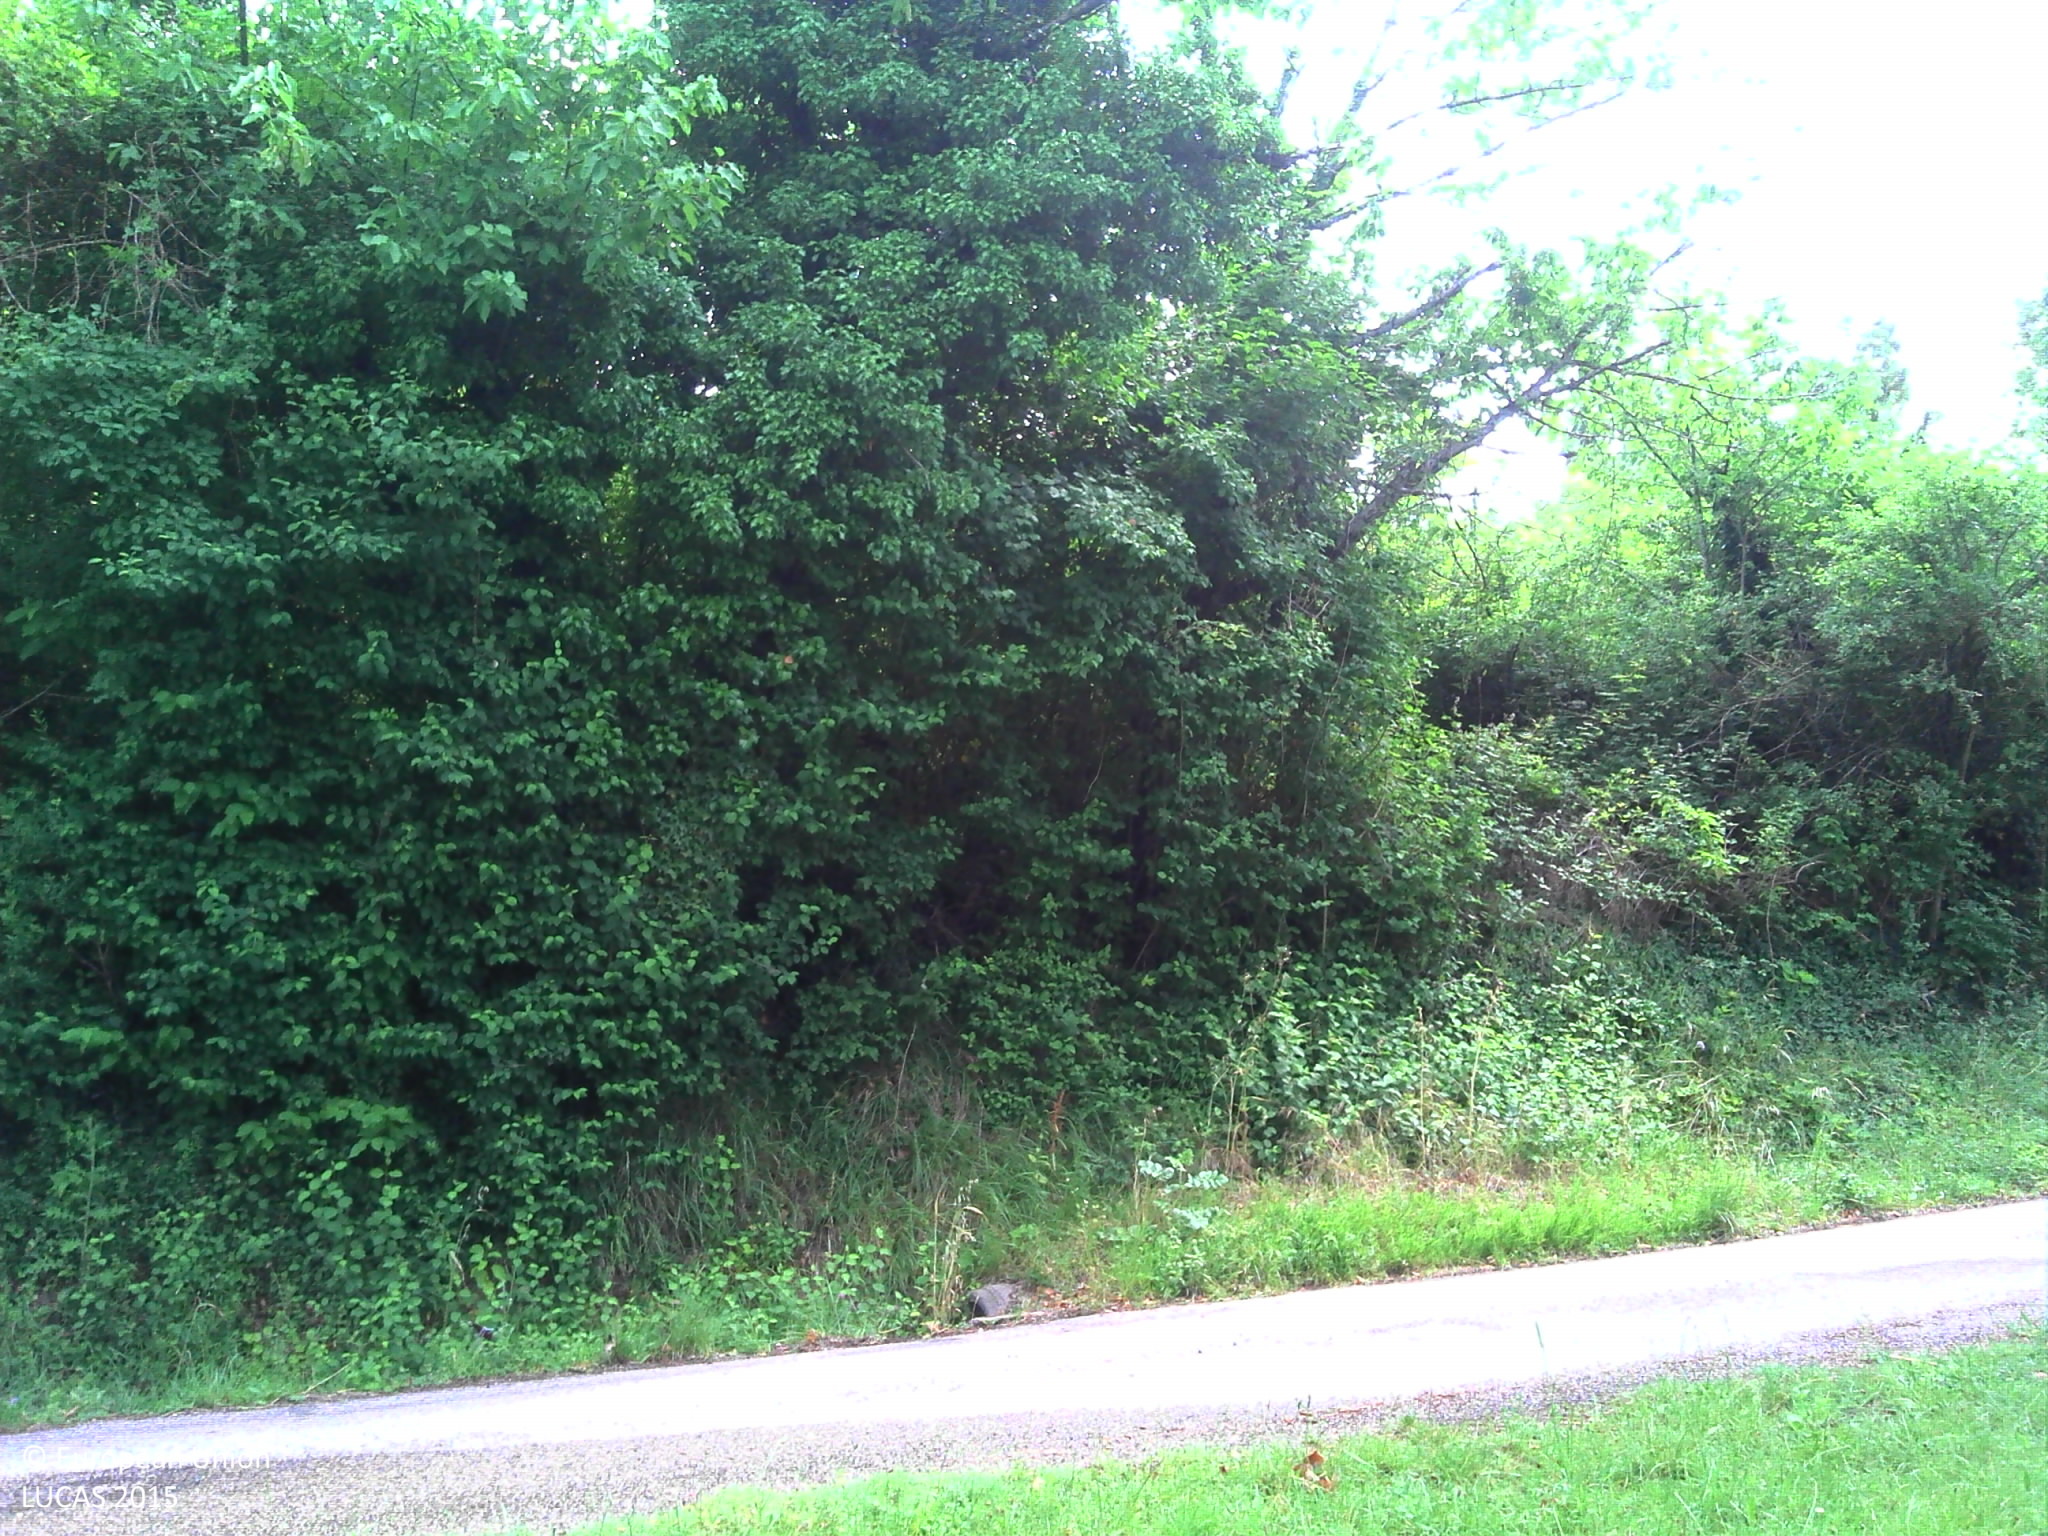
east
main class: Grassland
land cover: Grassland with sparse tree/shrub cover
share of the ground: > 75 %
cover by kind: herbaceous plants 95 %, broadleaved forest trees 5 %
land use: Residential
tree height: > 5 m
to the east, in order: Grassland with sparse tree/shrub cover; Artificial constructions in urban areas; Broadleaved woodland; Artificial constructions in urban areas; Broadleaved woodland
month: June
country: FR
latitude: 44.7919
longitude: 5.0386
